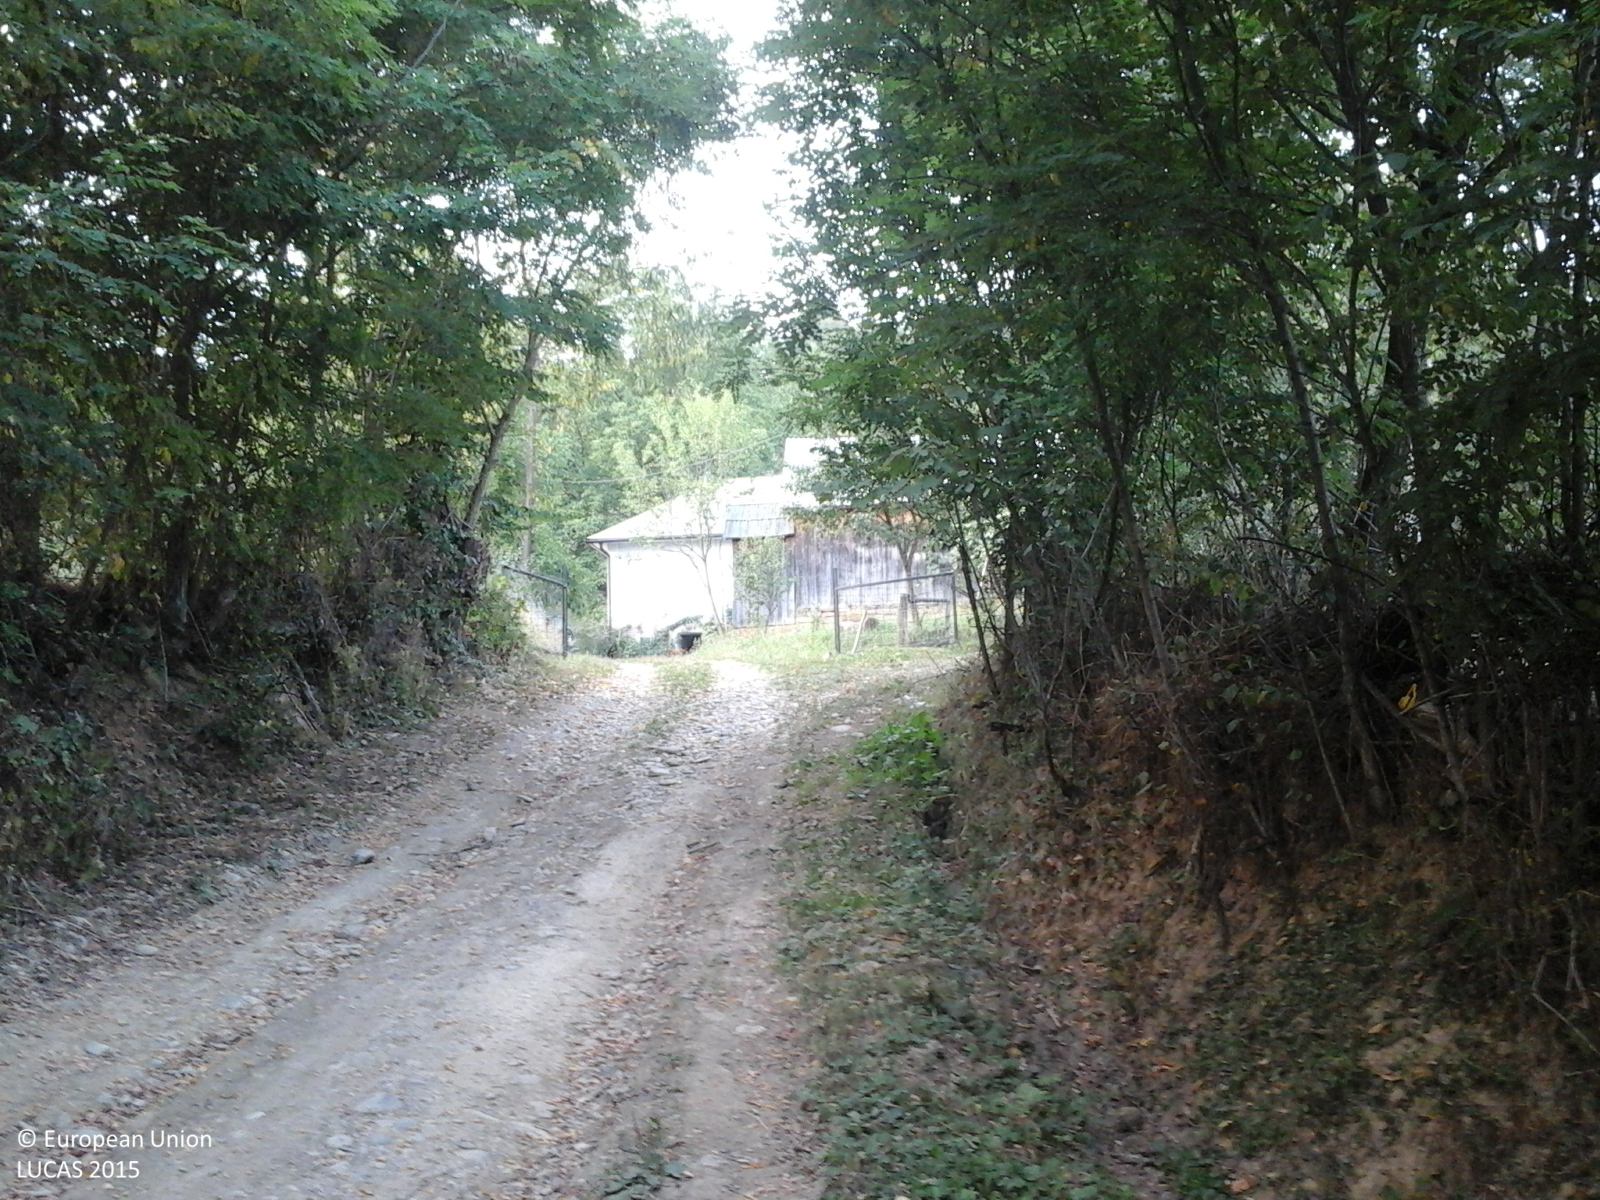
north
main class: Cropland
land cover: Other fruit trees and berries
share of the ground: 10 - 25 %
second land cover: Grassland without tree/shrub cover
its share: > 75 %
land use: Agriculture (excluding fallow land and kitchen gardens)
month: September
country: RO
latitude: 47.7323
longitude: 24.3729
